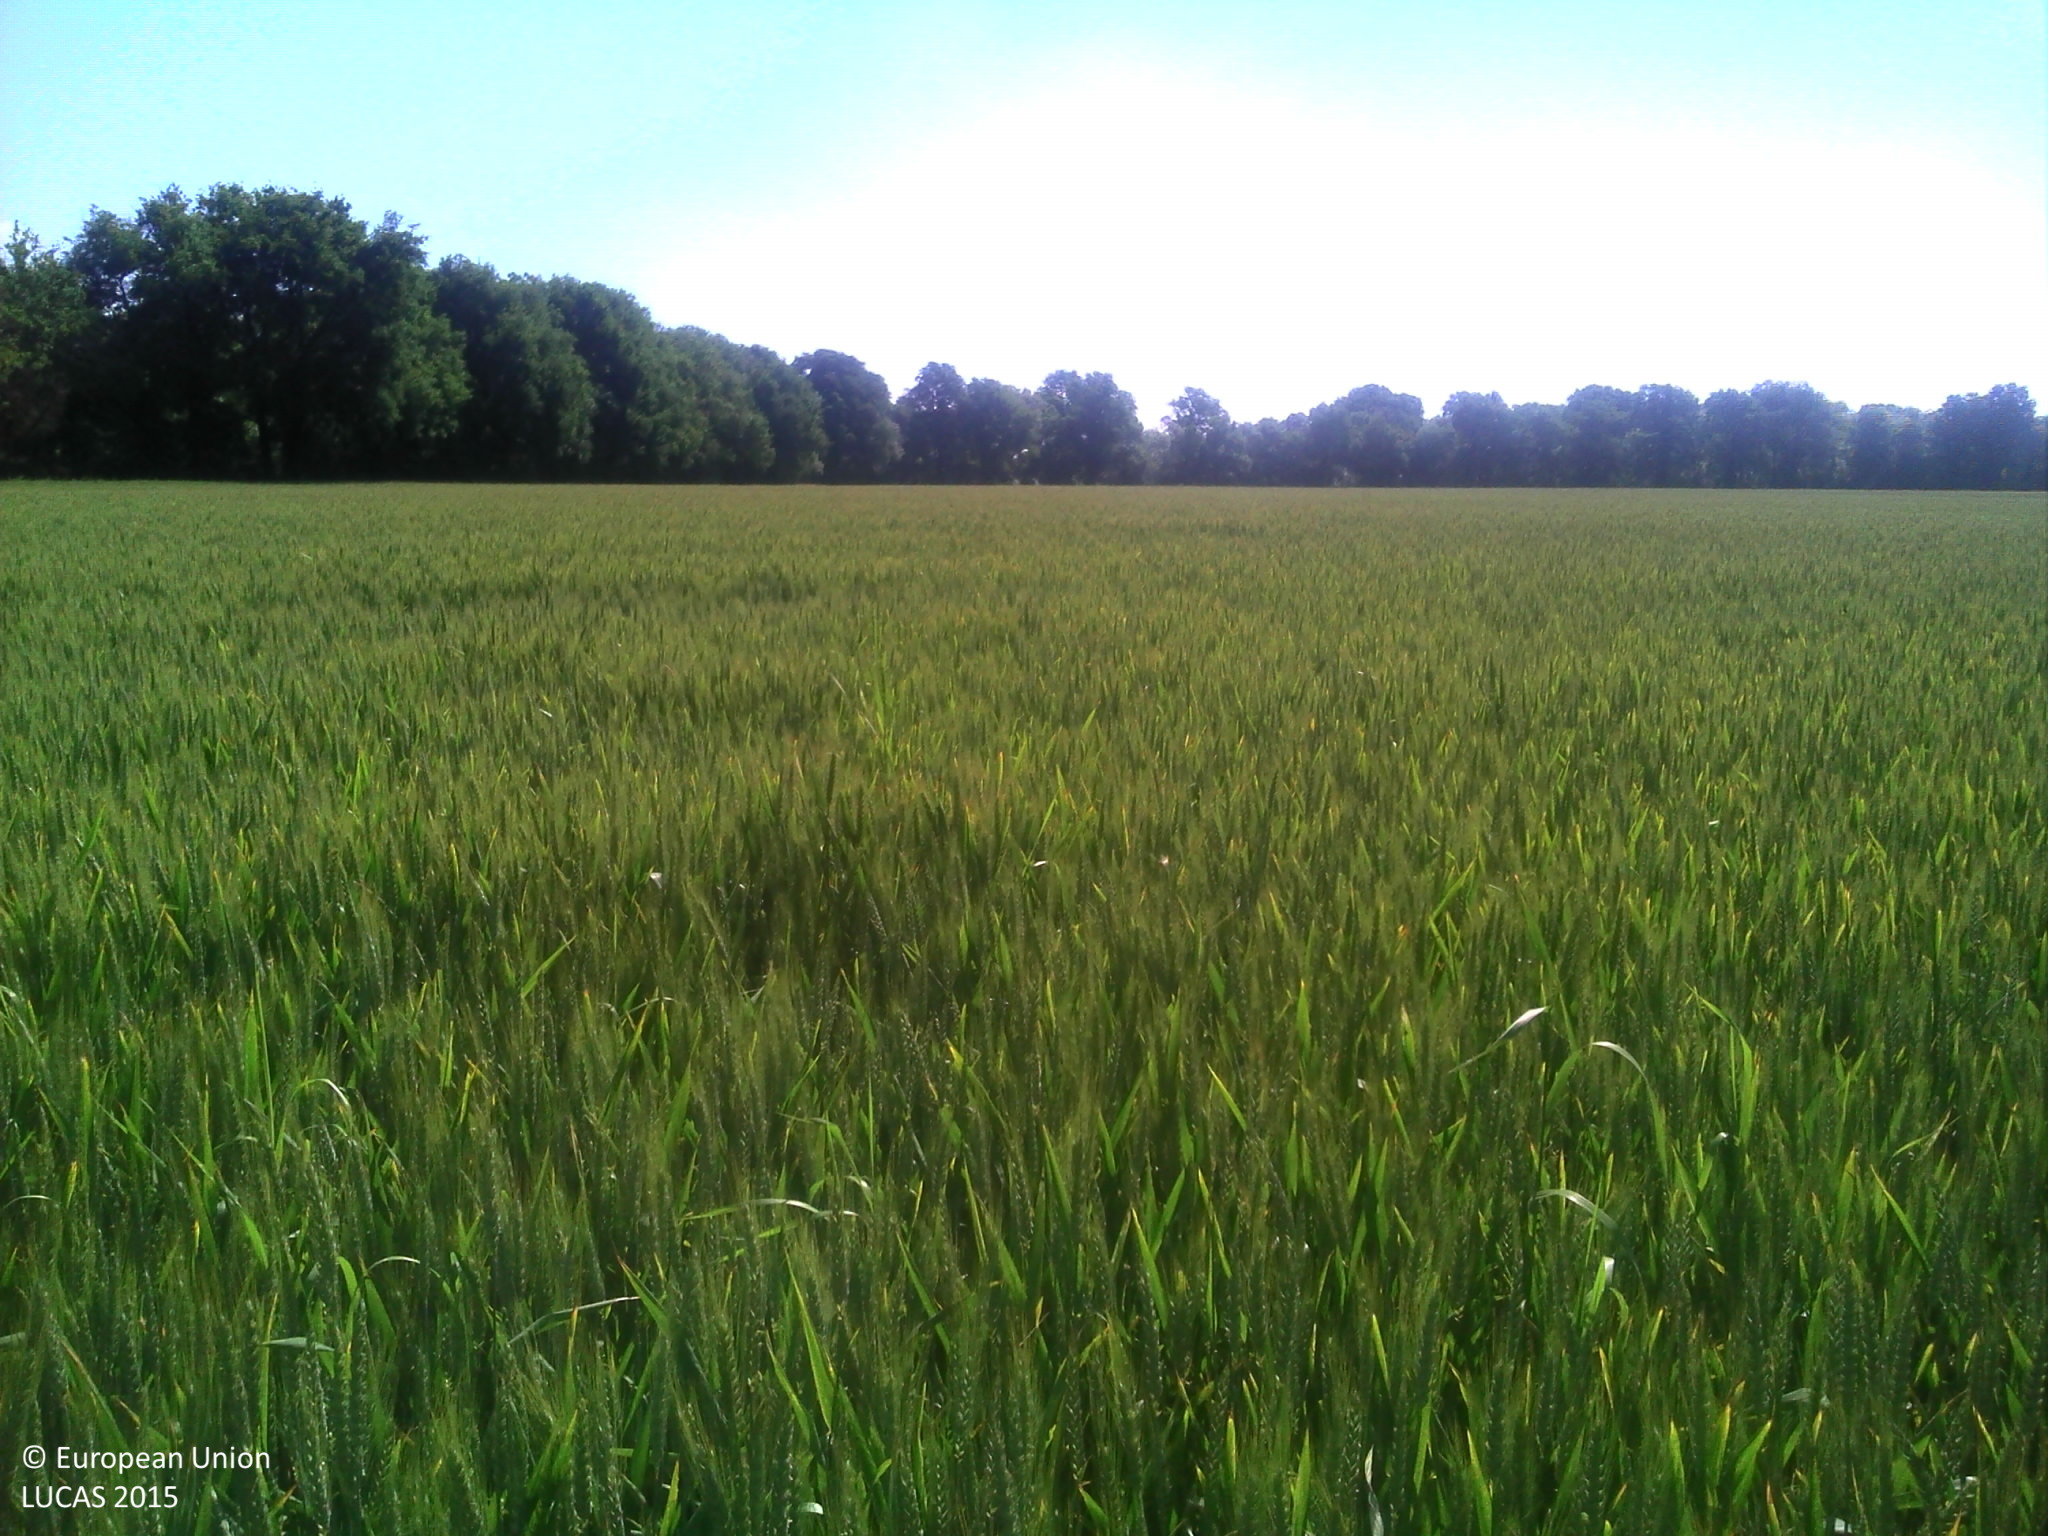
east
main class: Cropland
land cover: Common wheat
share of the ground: > 75 %
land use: Agriculture (excluding fallow land and kitchen gardens)
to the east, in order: Common wheat
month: May
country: FR
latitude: 47.3790
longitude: -1.0163
